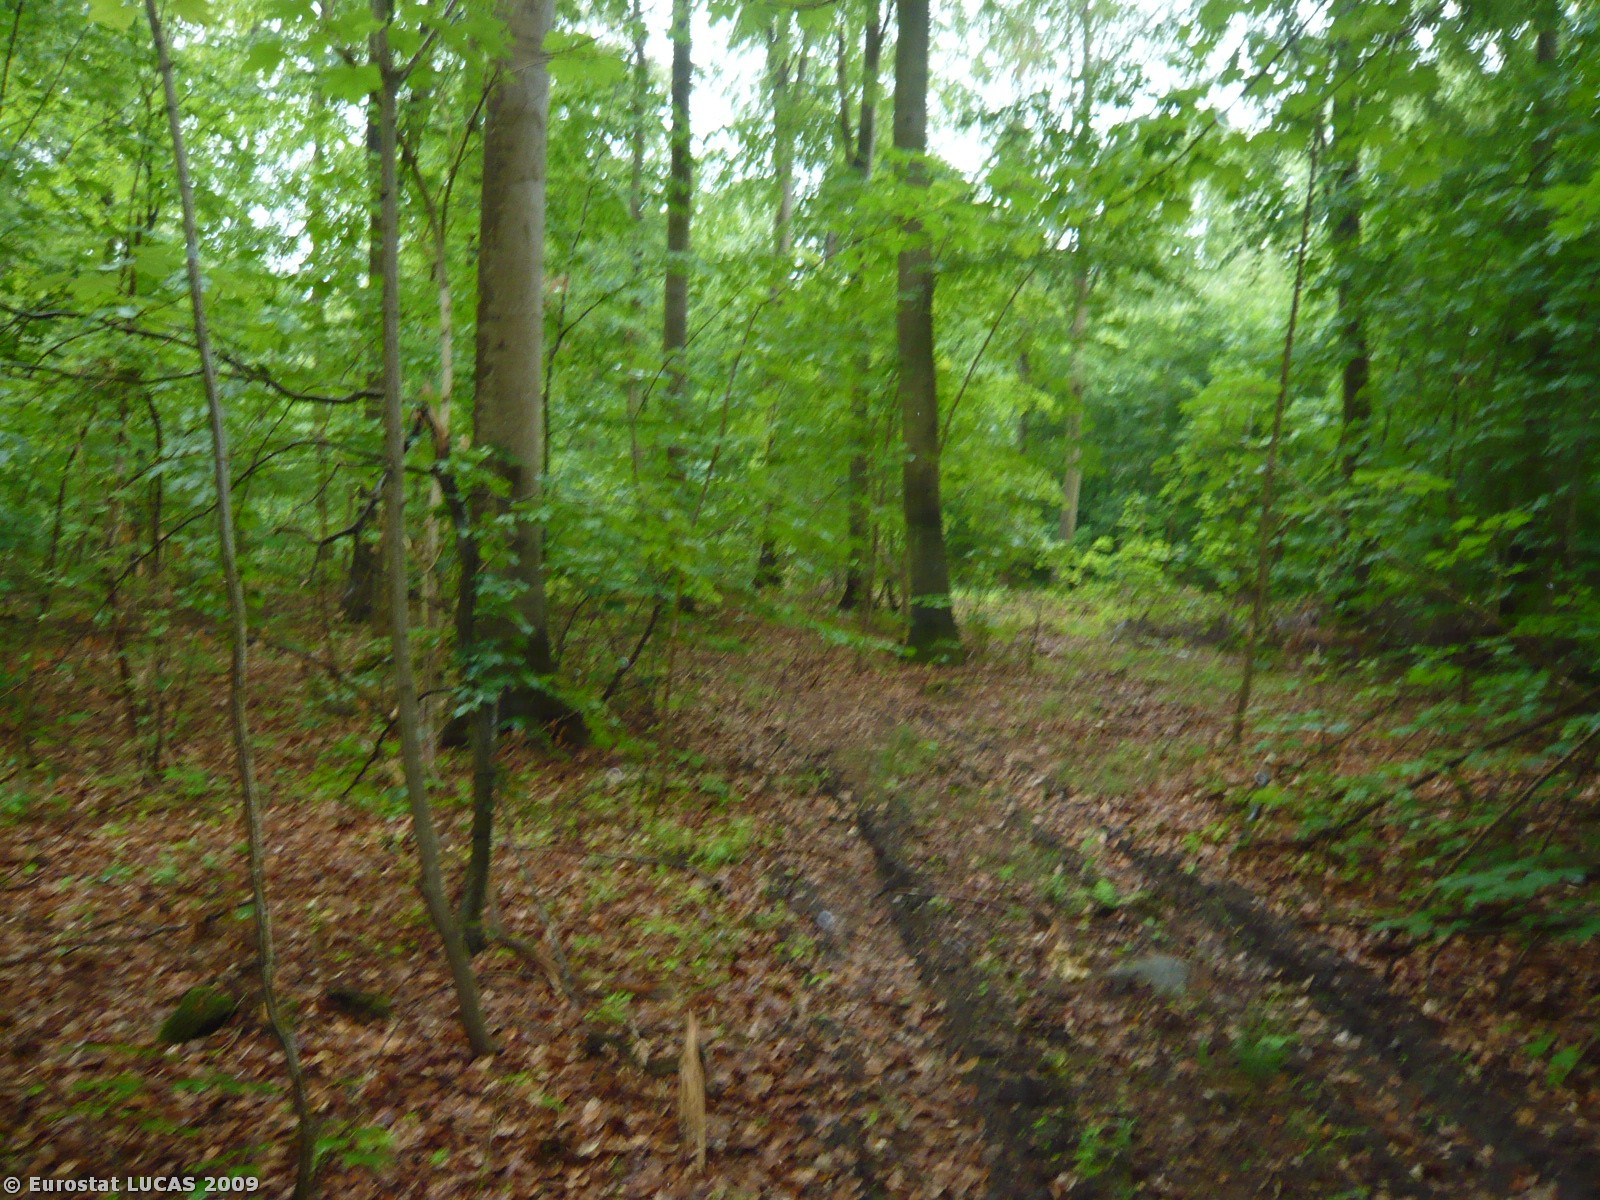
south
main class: Woodland
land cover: Broadleaved woodland
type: mesophytic deciduous forest
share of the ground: > 75 %
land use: Forestry
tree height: > 5 m
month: June
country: DK
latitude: 54.8255
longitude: 11.8822
